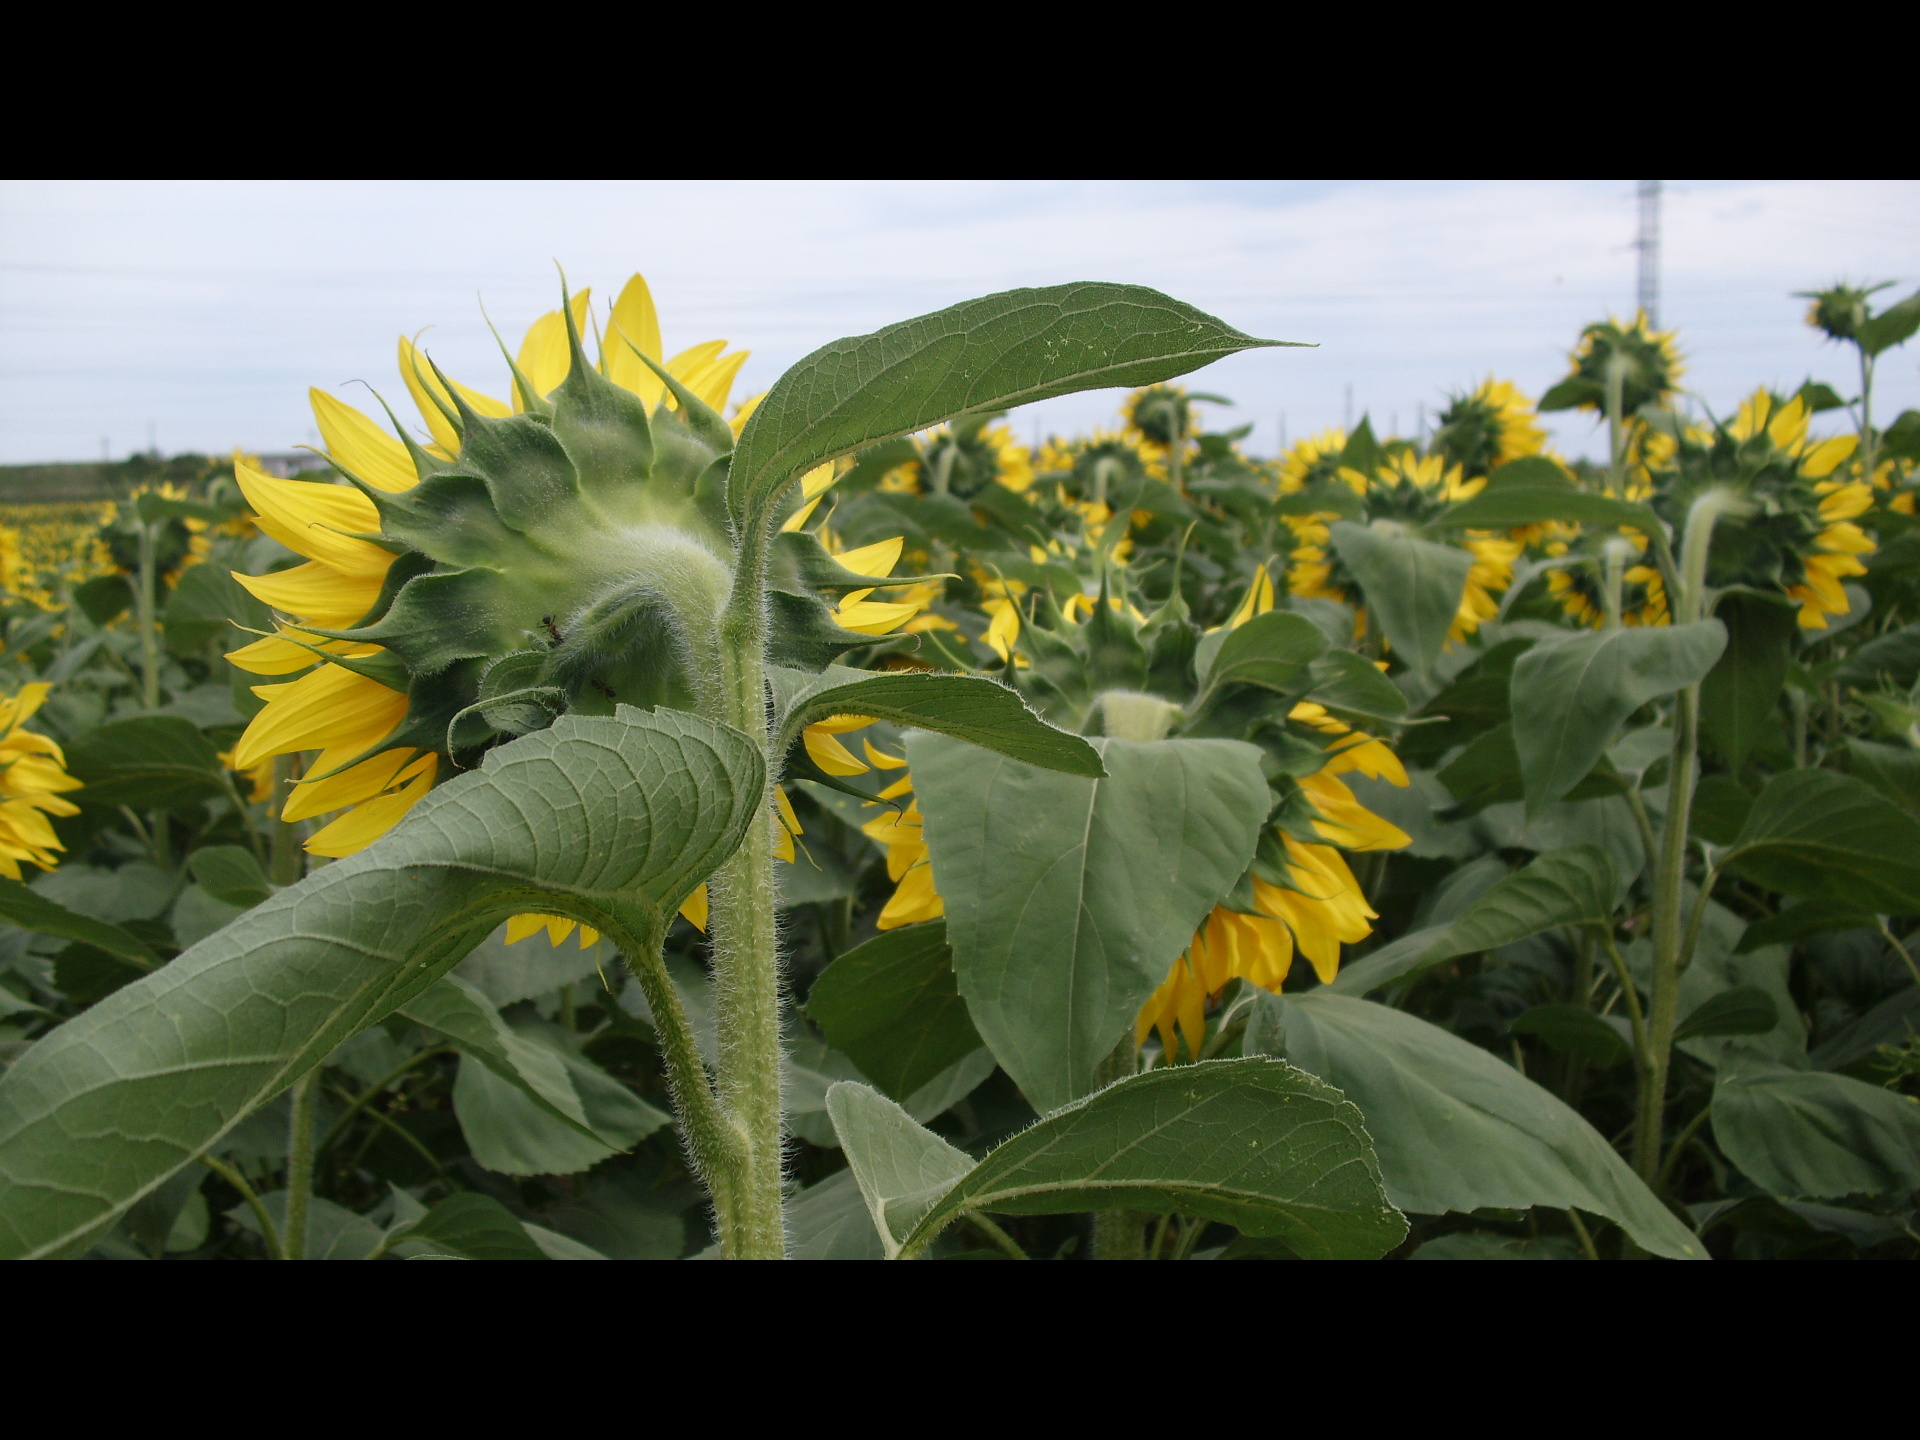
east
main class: Cropland
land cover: Sunflower
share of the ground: > 75 %
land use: Agriculture (excluding fallow land and kitchen gardens)
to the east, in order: Sunflower; Electric lines; Sunflower; Electric lines; Sunflower
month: July
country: BG
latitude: 43.9688
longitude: 22.8398
